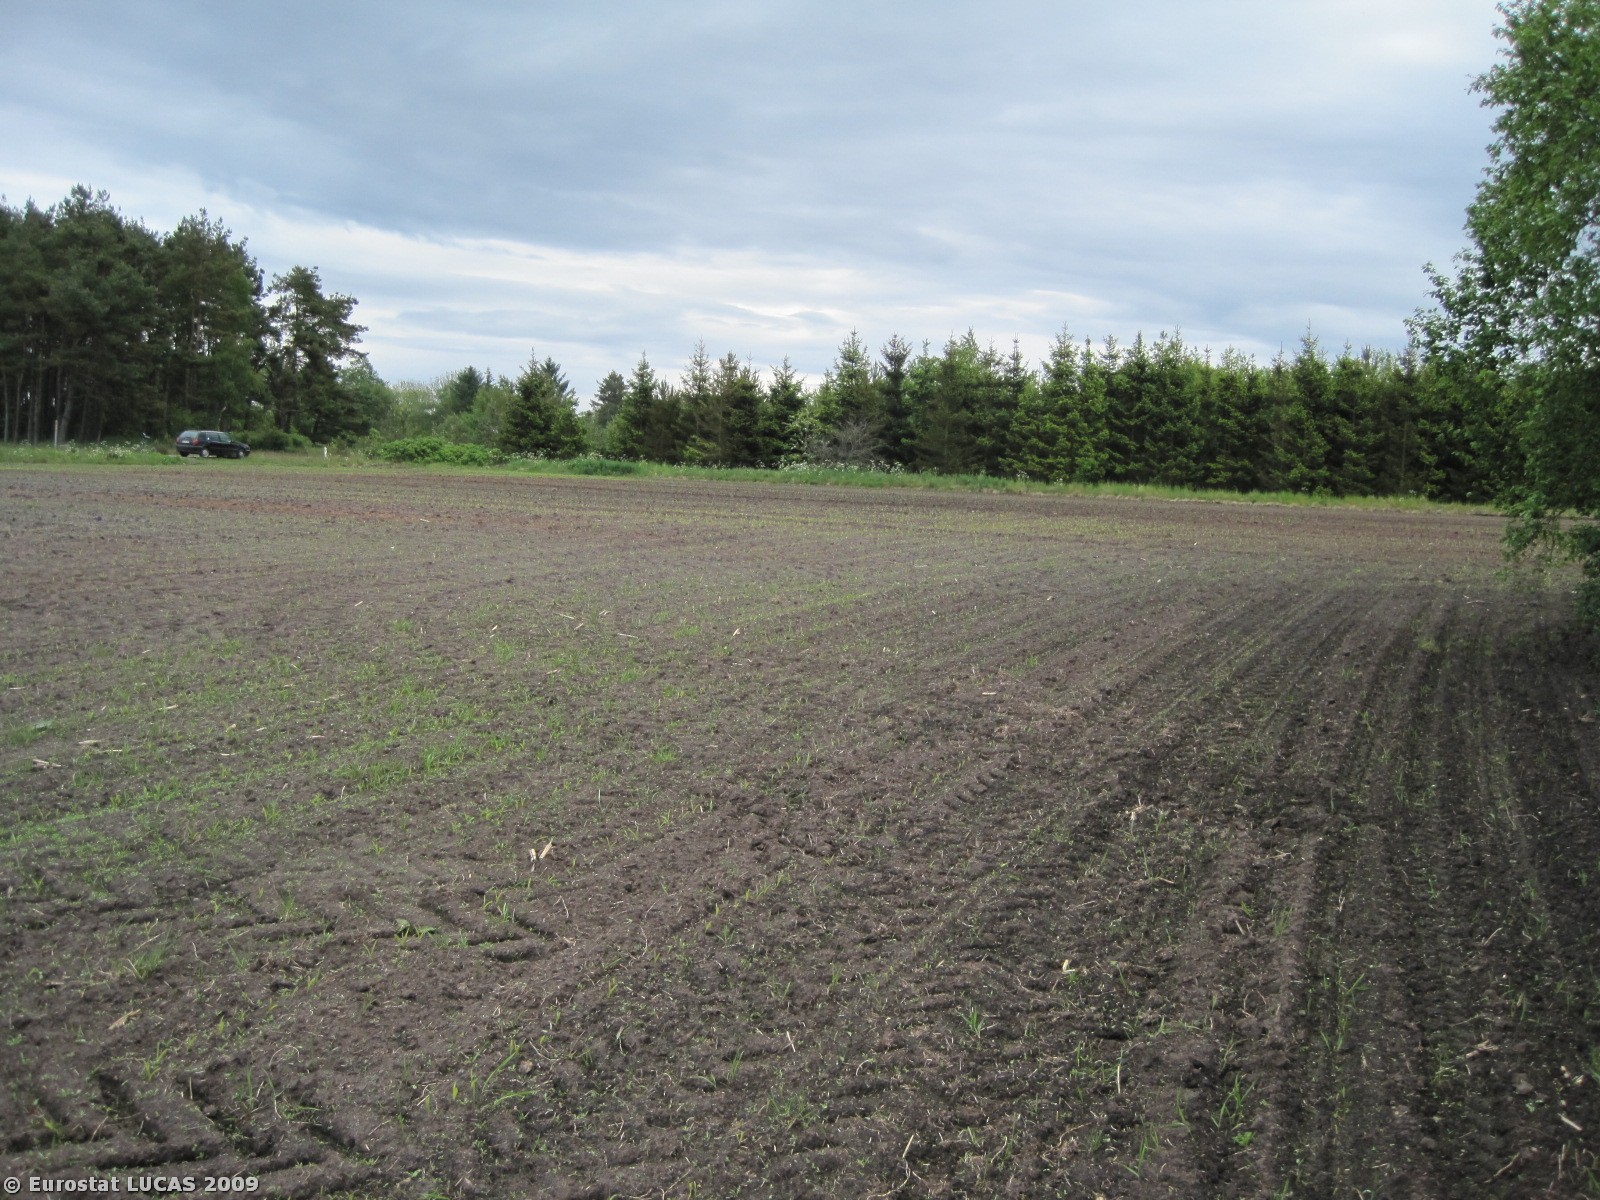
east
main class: Cropland
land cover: Maize
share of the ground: < 10 %
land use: Agriculture (excluding fallow land and kitchen gardens)
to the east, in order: Maize; Grassland without tree/shrub cover; Coniferous woodland; Broadleaved woodland; Ditches and canals; Grass margins; Paved roads, cycling and walking lanes; Grass margins; Ditches and canals; Grassland without tree/shrub cover; Coniferous woodland; Grassland without tree/shrub cover; Coniferous woodland; Barley
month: May
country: DK
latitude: 56.7270
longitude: 10.0490
